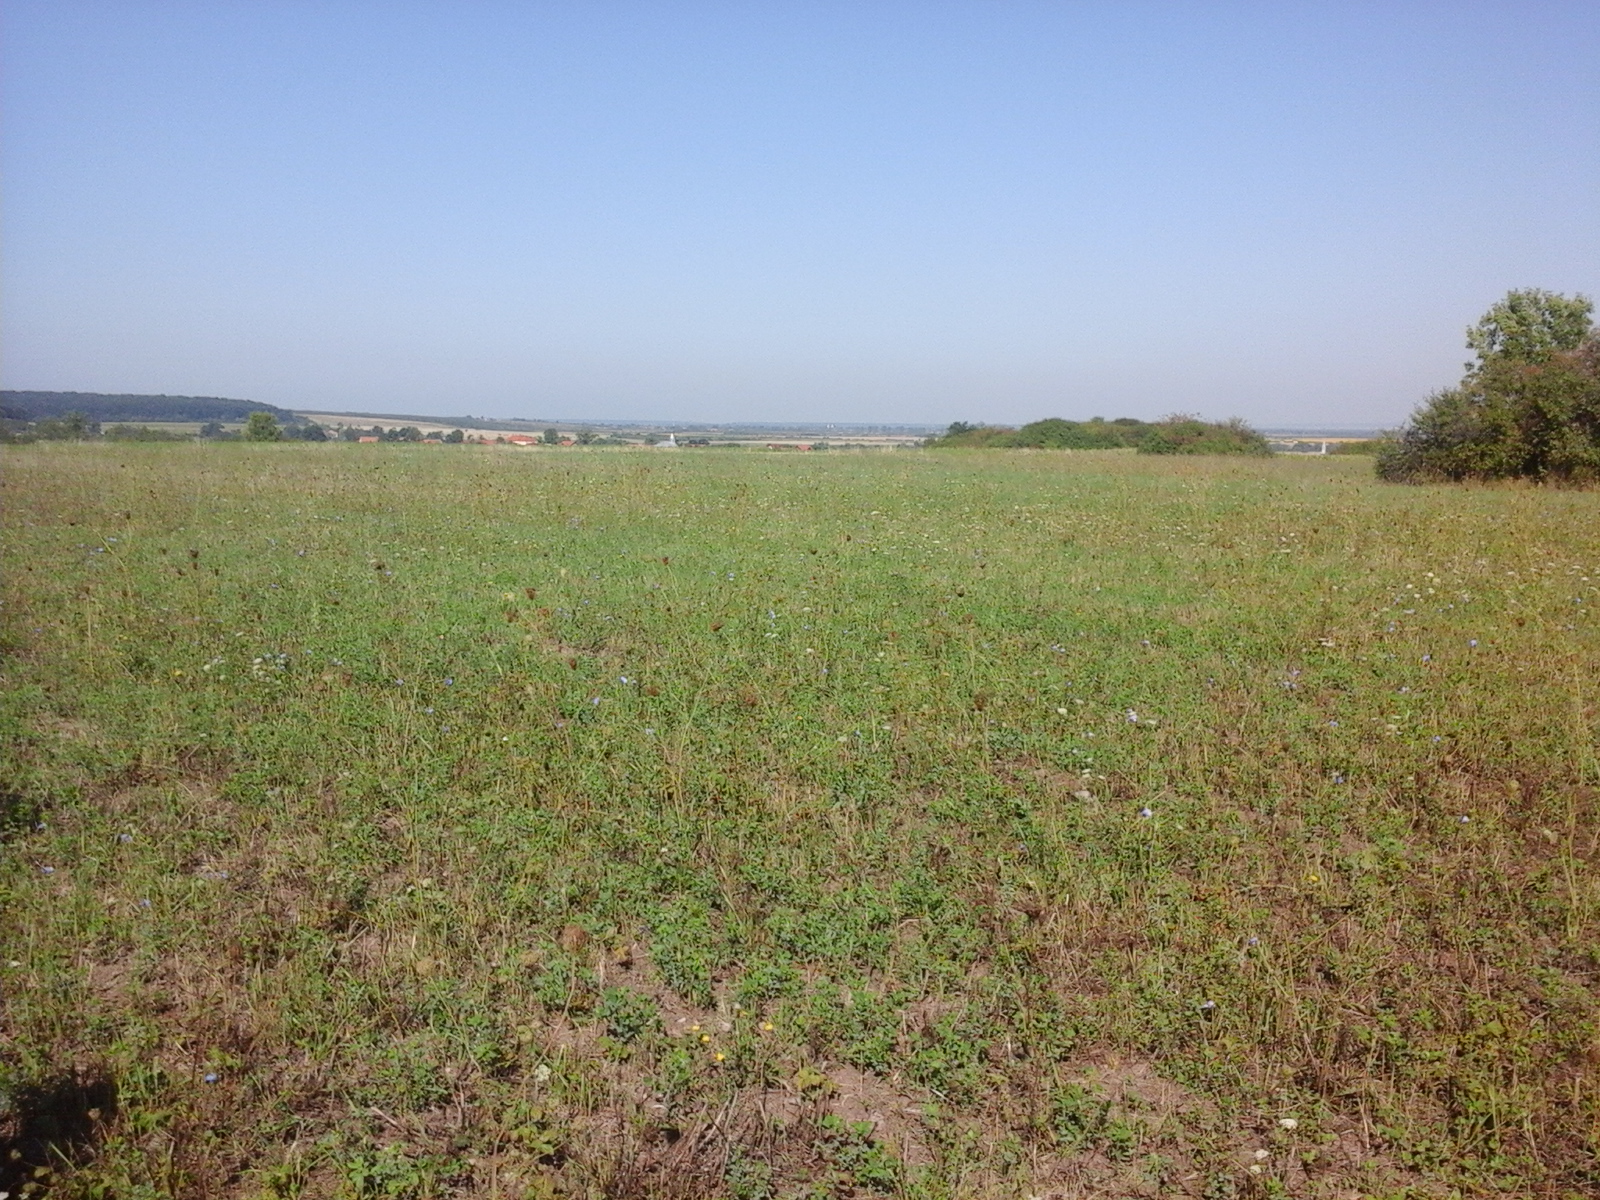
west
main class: Grassland
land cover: Grassland without tree/shrub cover
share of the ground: > 75 %
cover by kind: herbaceous plants 100 %
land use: Agriculture (excluding fallow land and kitchen gardens)
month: August
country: RO
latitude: 45.6670
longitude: 21.7293
